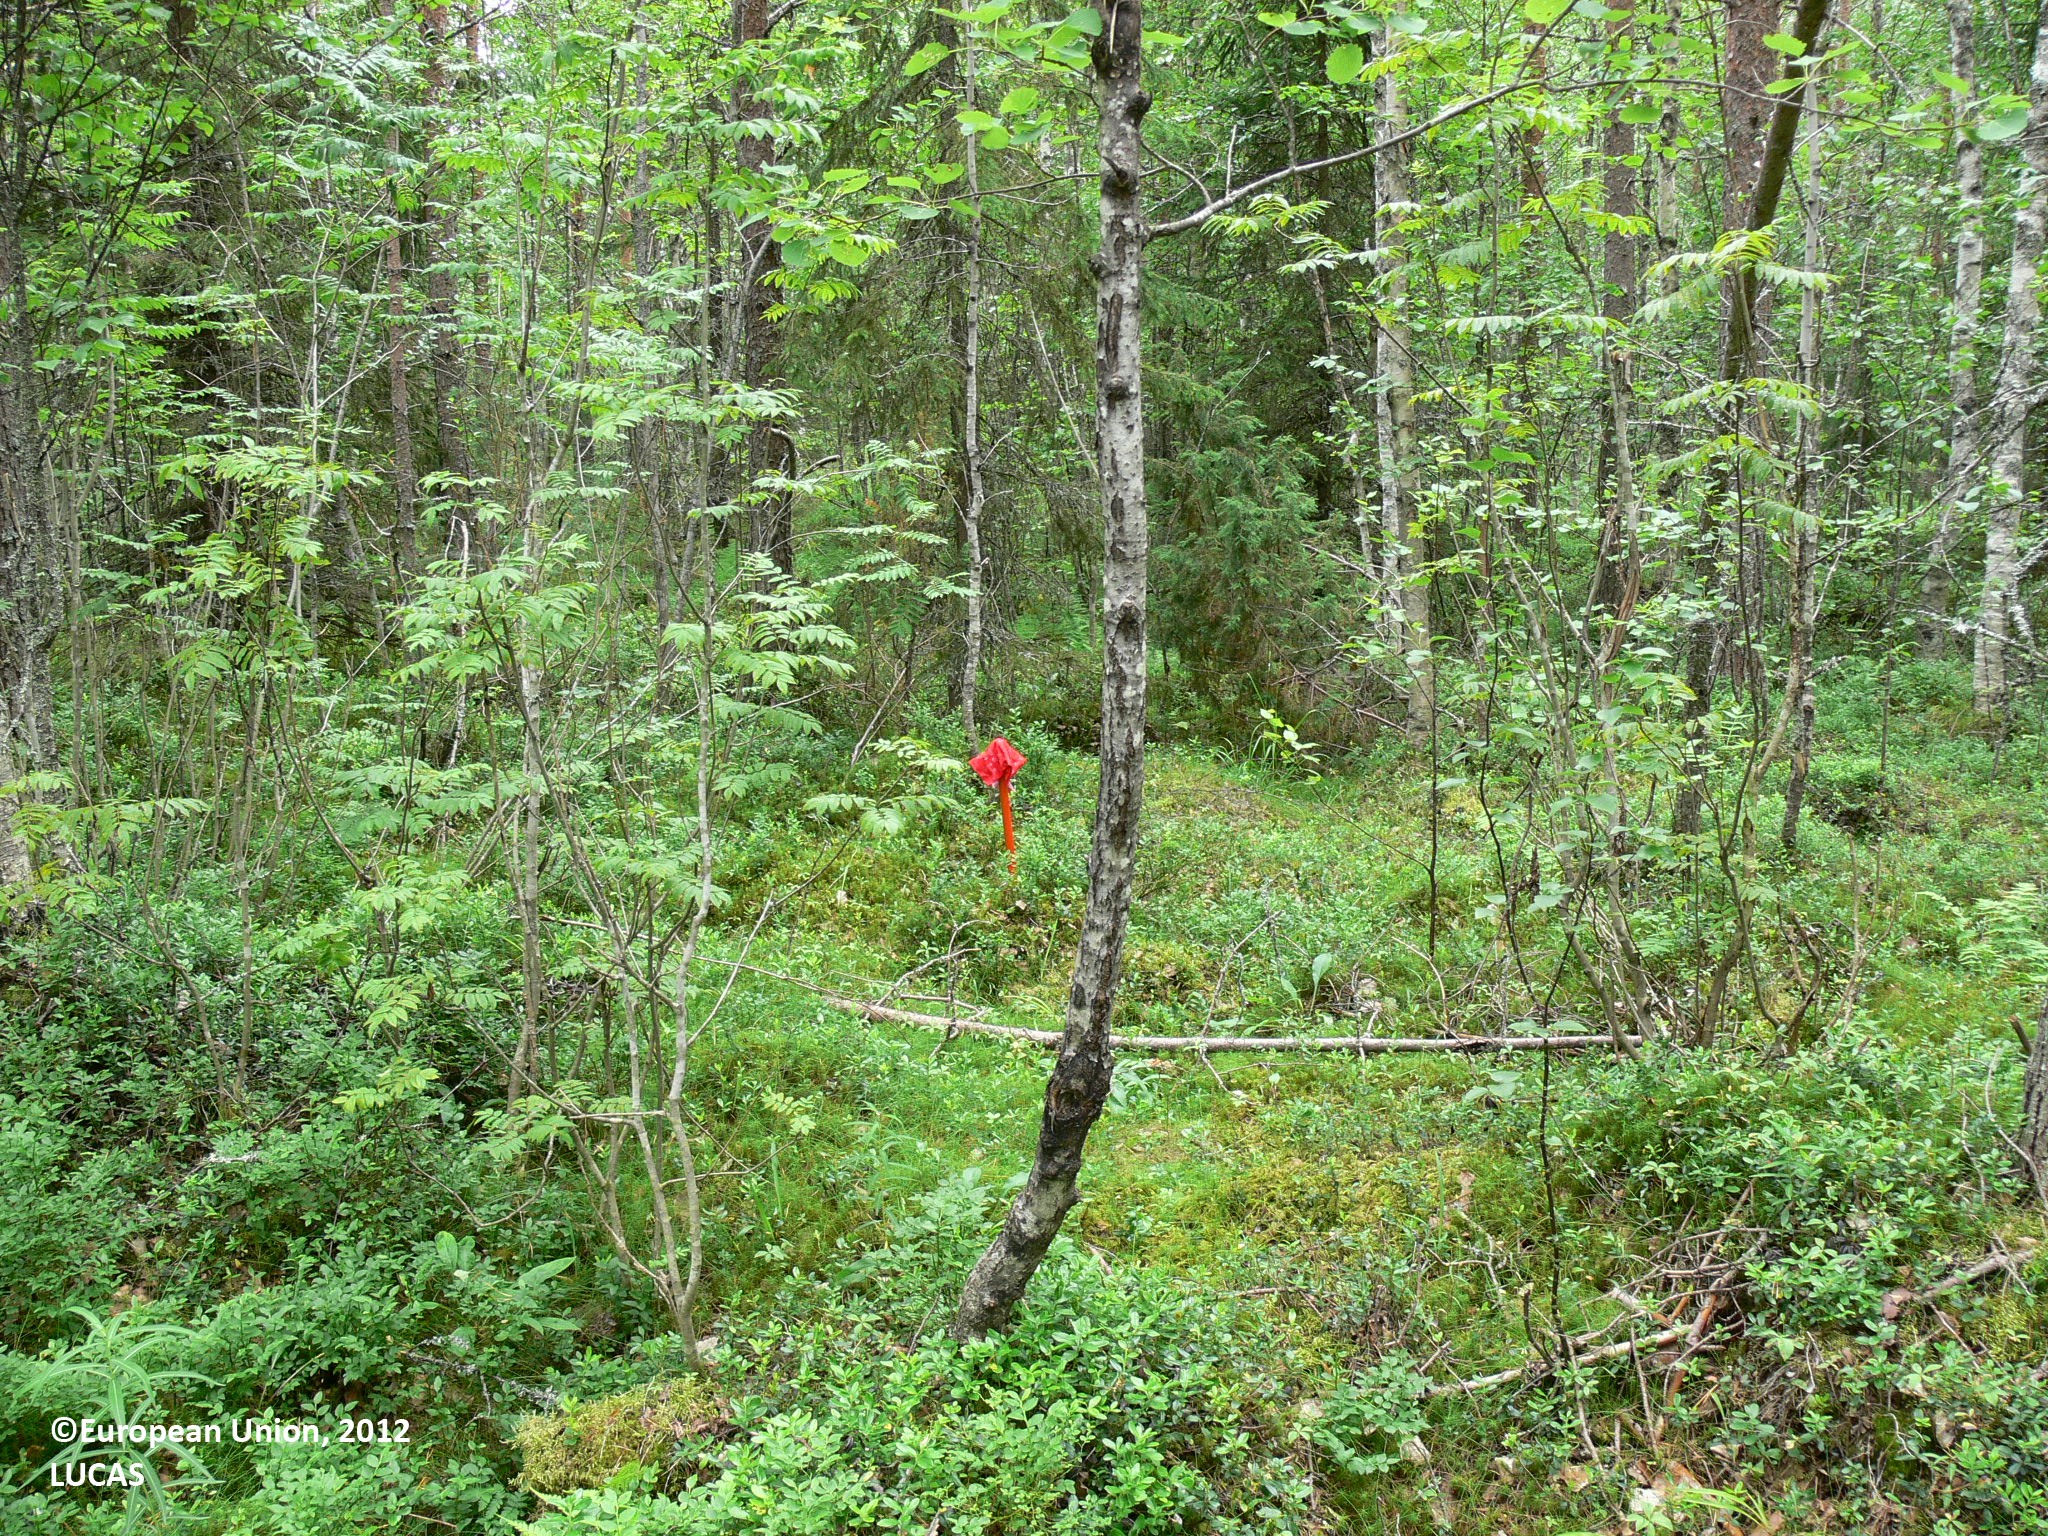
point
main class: Woodland
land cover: Other mixed woodland
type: boreal forest
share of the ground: > 75 %
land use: Forestry
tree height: > 5 m
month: July
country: FI
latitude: 63.2288
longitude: 30.7202
